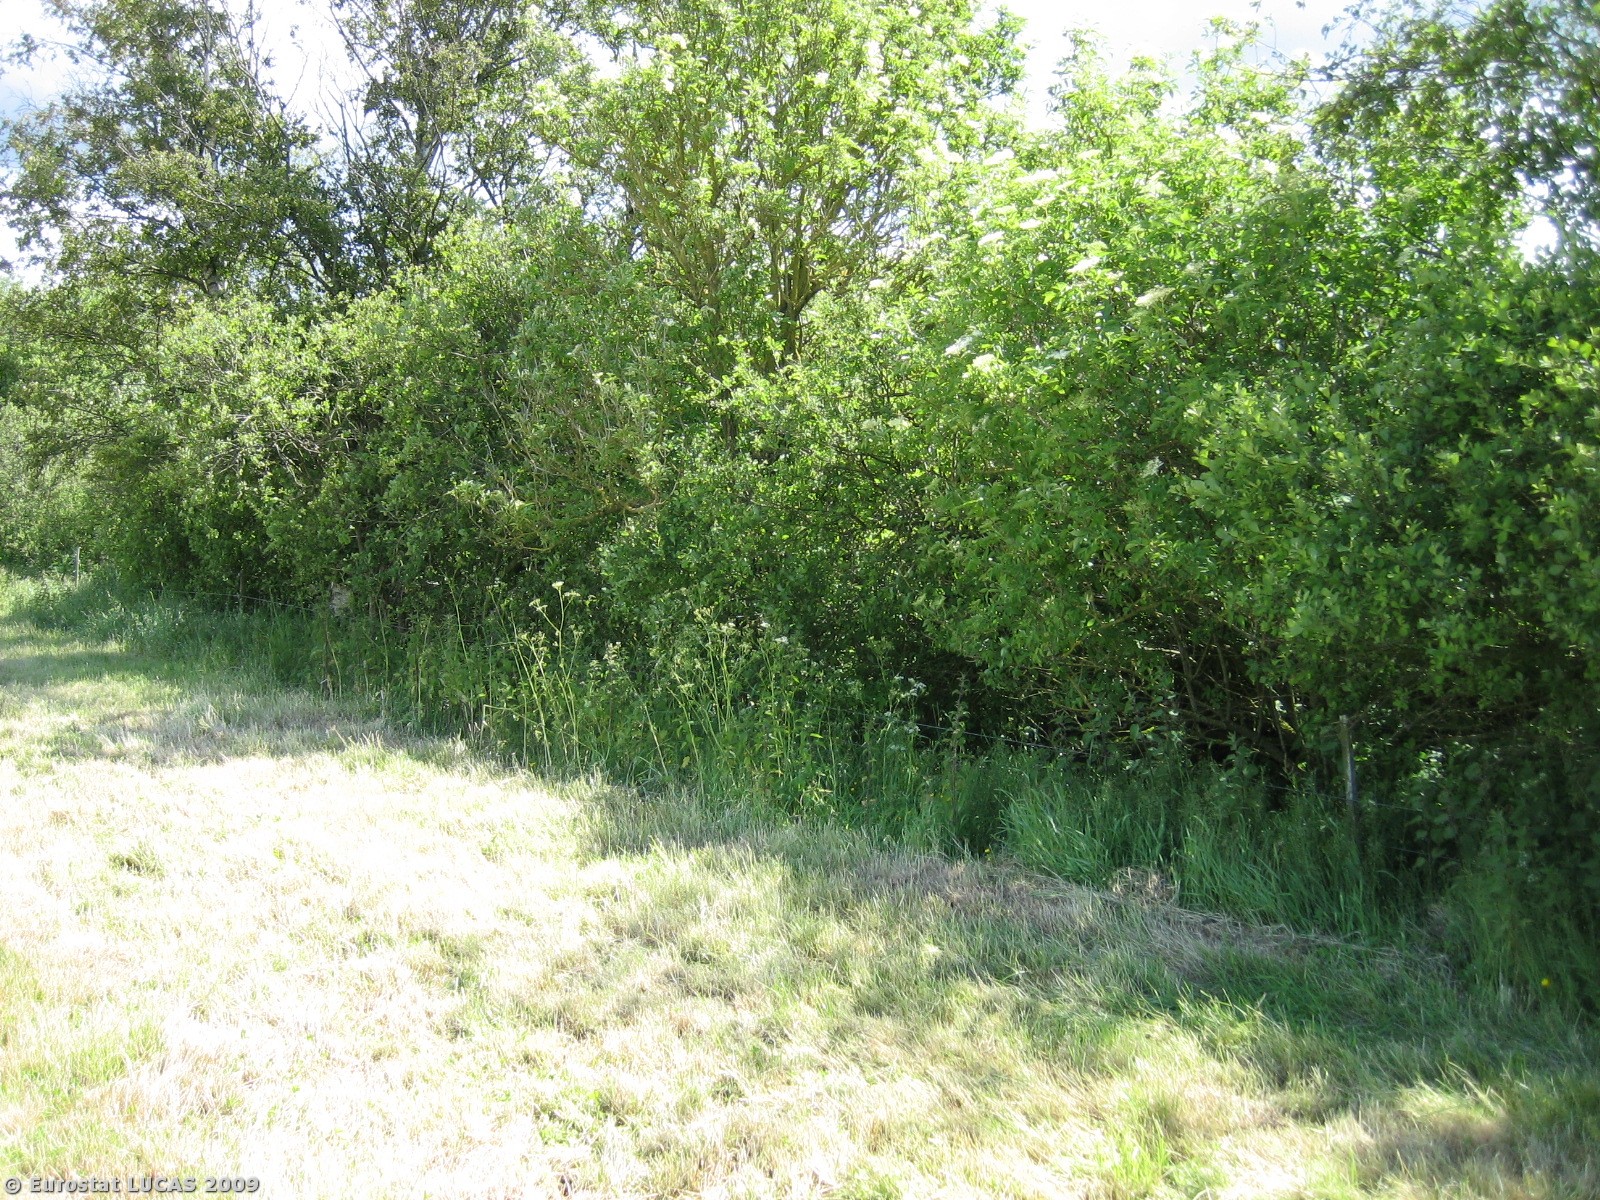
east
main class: Cropland
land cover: Temporary grasslands
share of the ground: > 75 %
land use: Agriculture (excluding fallow land and kitchen gardens)
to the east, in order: Temporary grasslands; Fences; Broadleaved woodland; Rye
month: June
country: DK
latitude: 55.5927
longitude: 9.3183
